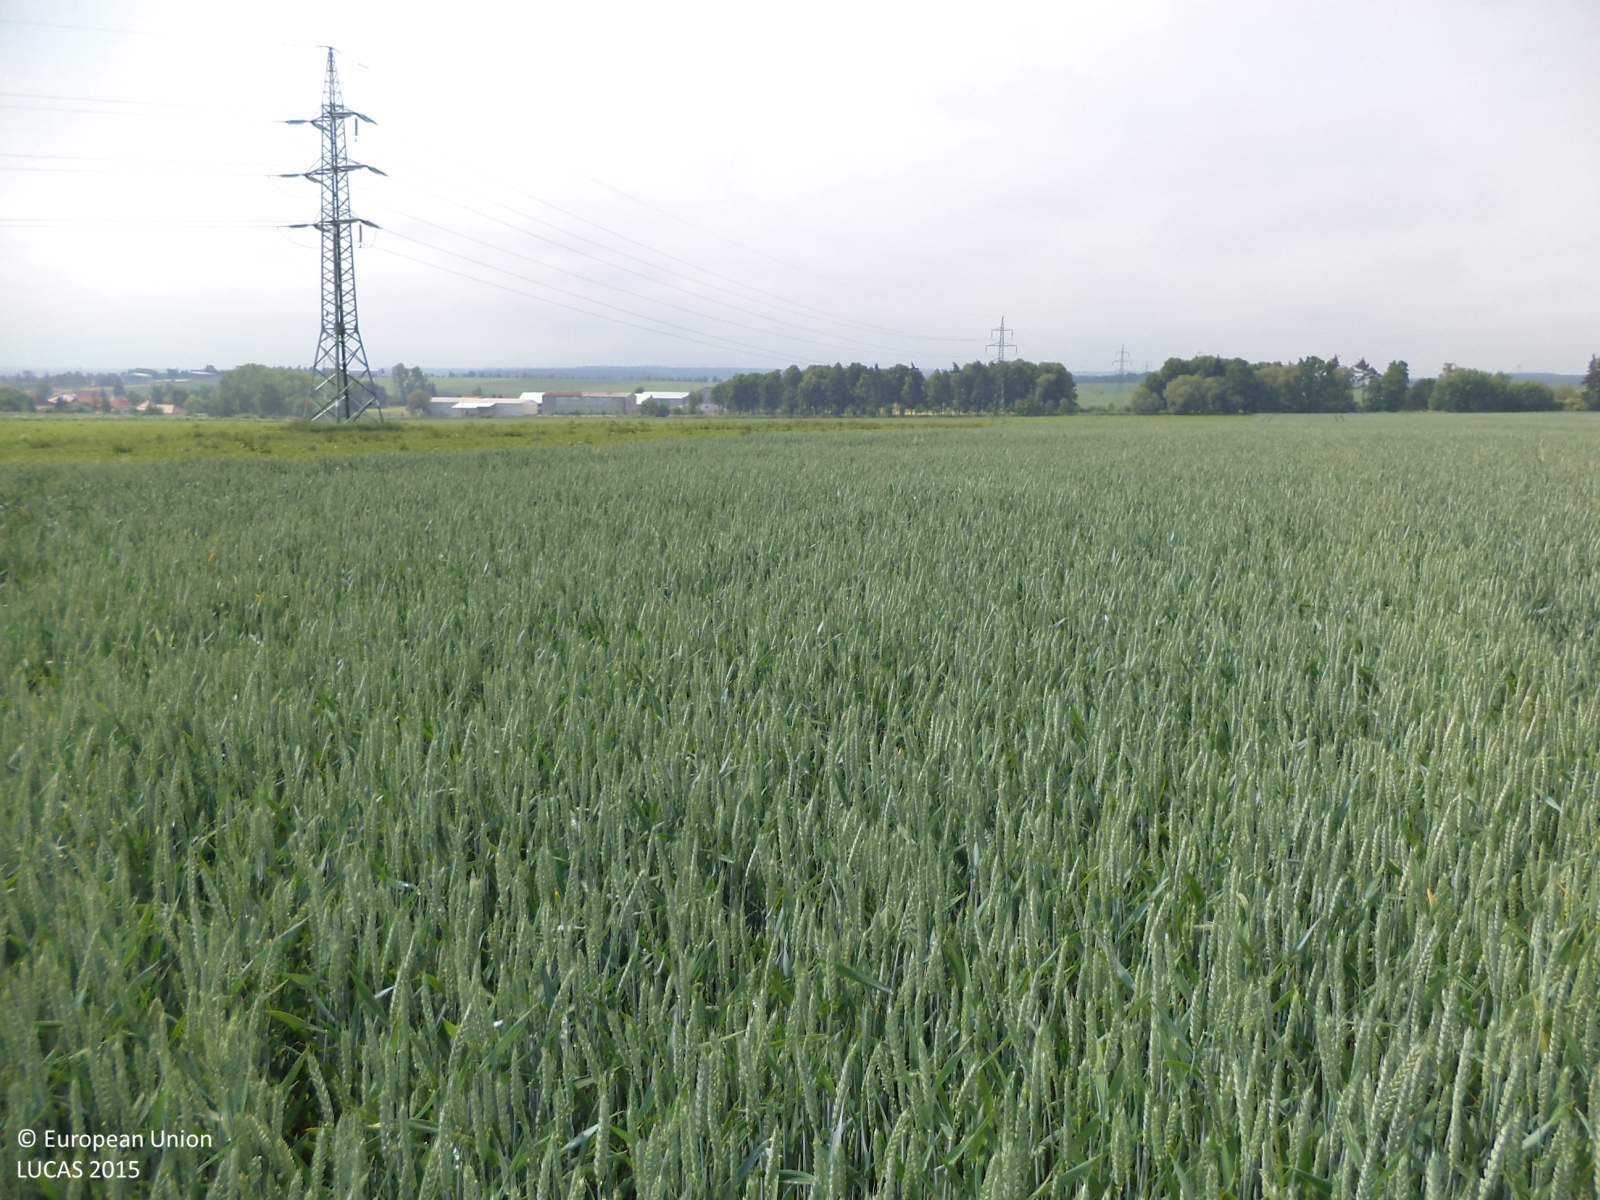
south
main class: Cropland
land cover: Common wheat
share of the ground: > 75 %
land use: Agriculture (excluding fallow land and kitchen gardens)
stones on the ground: < 10 %
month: June
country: CZ
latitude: 49.1370
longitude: 14.5931
